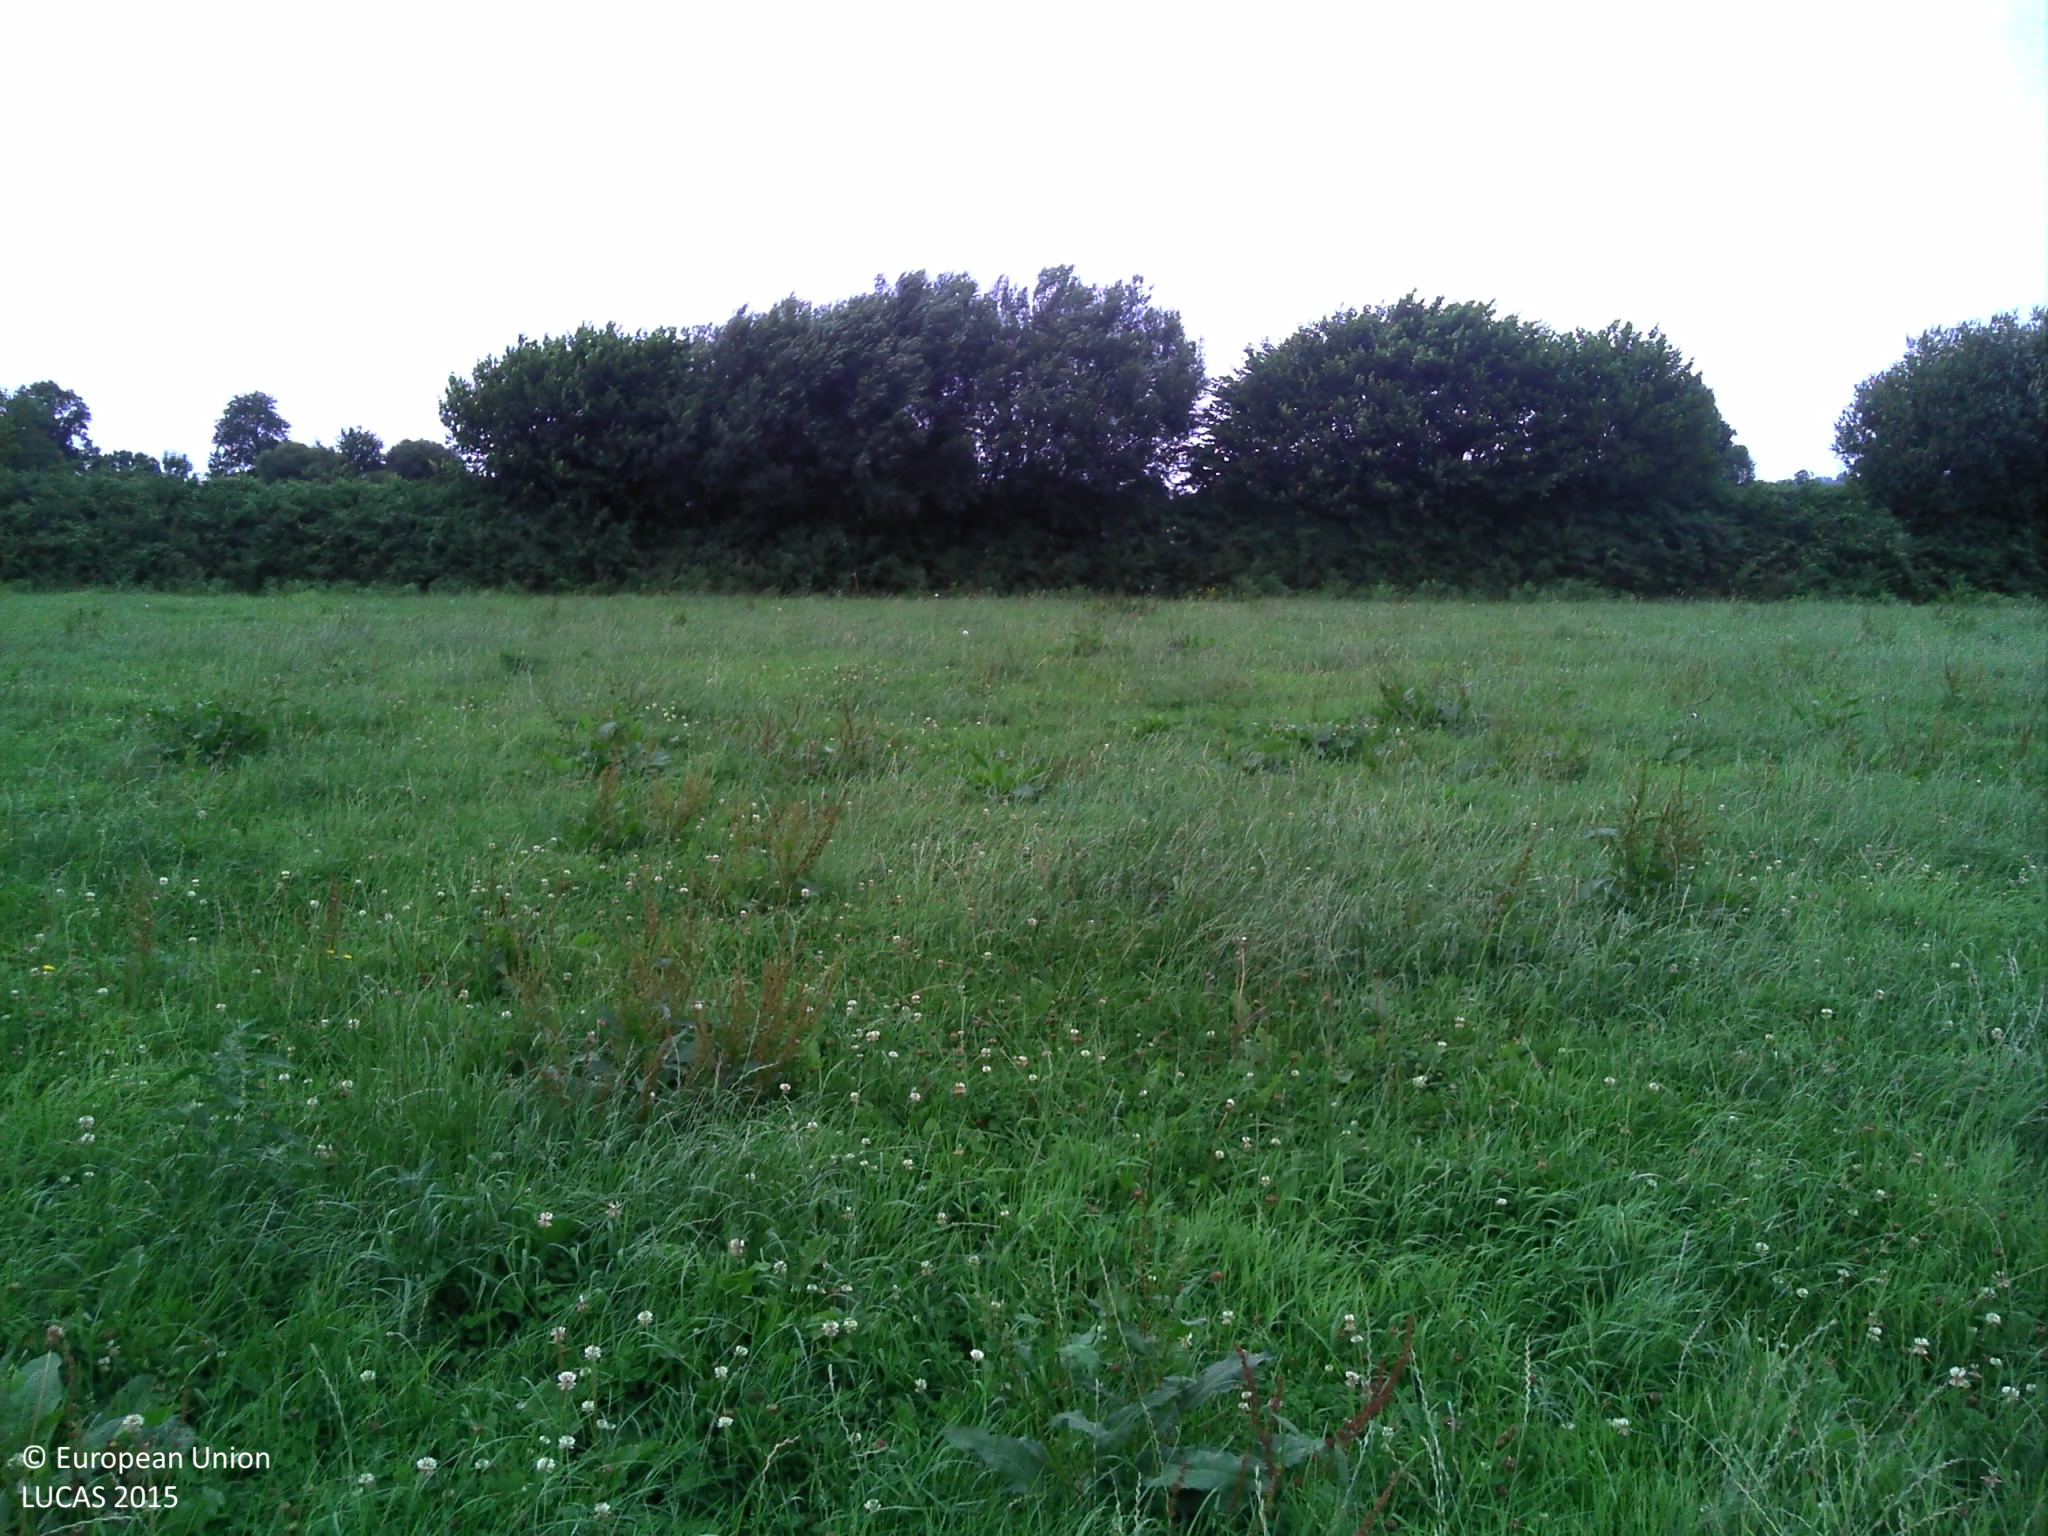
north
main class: Grassland
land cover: Grassland without tree/shrub cover
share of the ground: > 75 %
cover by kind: herbaceous plants 100 %
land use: Agriculture (excluding fallow land and kitchen gardens)
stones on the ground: < 10 %
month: July
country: FR
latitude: 48.8503
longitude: -1.3712
